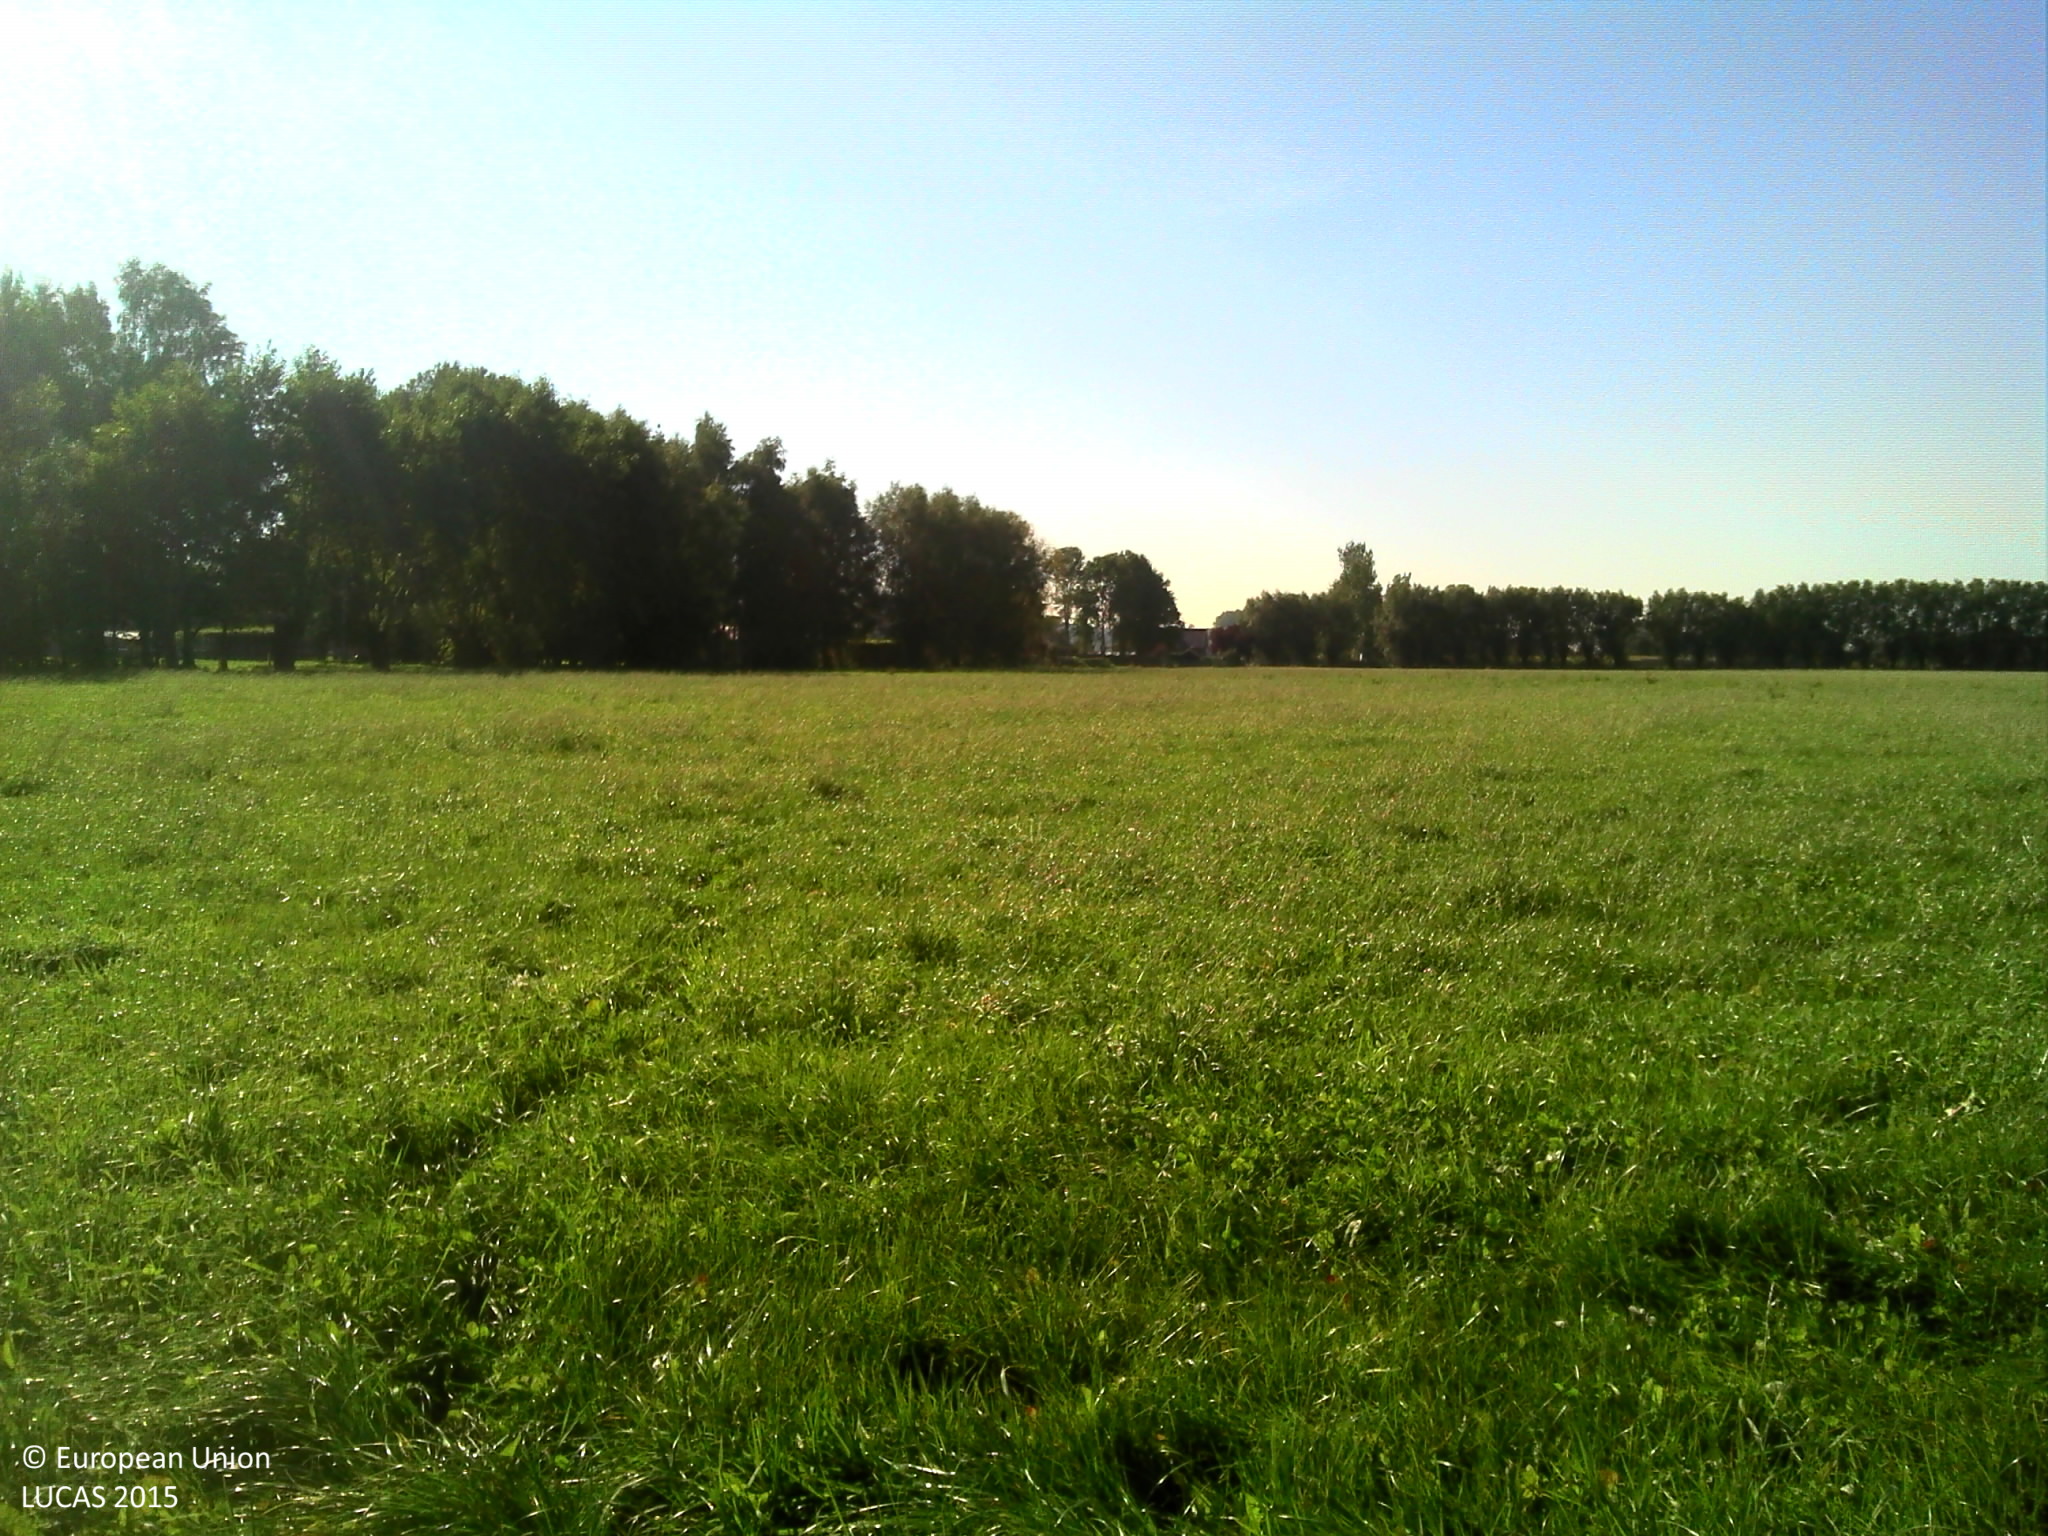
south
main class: Grassland
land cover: Grassland without tree/shrub cover
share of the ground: > 75 %
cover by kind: herbaceous plants 100 %
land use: Agriculture (excluding fallow land and kitchen gardens)
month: September
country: BE
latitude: 51.1477
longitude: 3.4016
